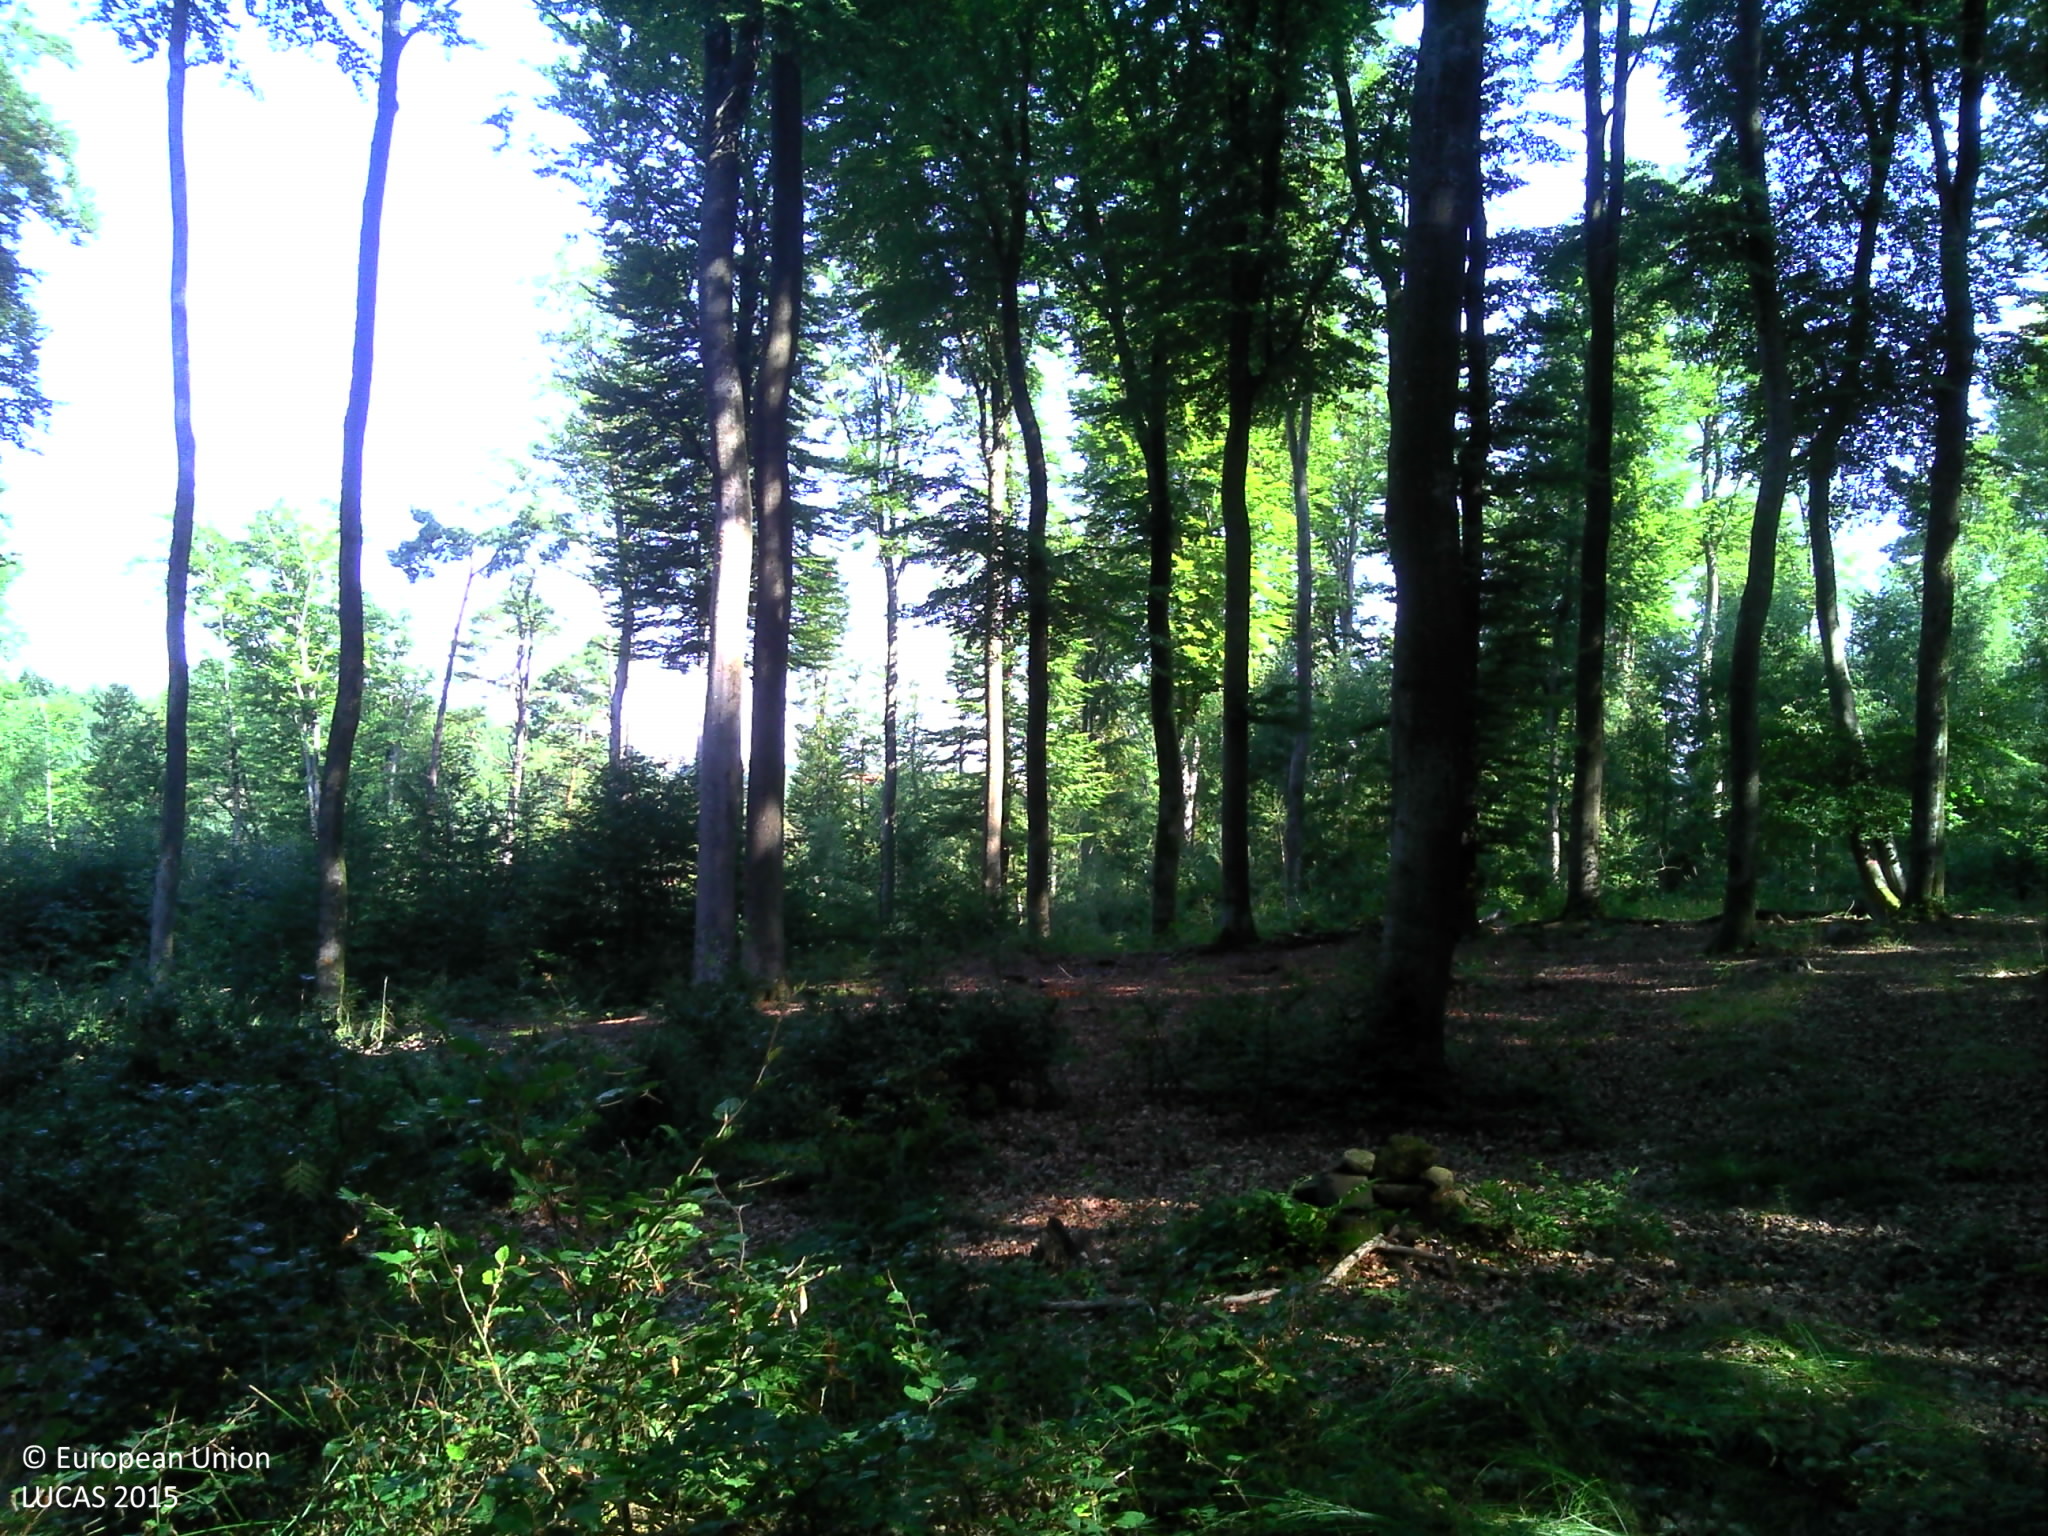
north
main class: Woodland
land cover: Broadleaved woodland
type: beech forest
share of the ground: > 75 %
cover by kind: broadleaved forest trees 95 %, herbaceous plants 5 %
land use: Forestry
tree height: > 5 m
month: August
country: FR
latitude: 48.9096
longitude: 7.2581
